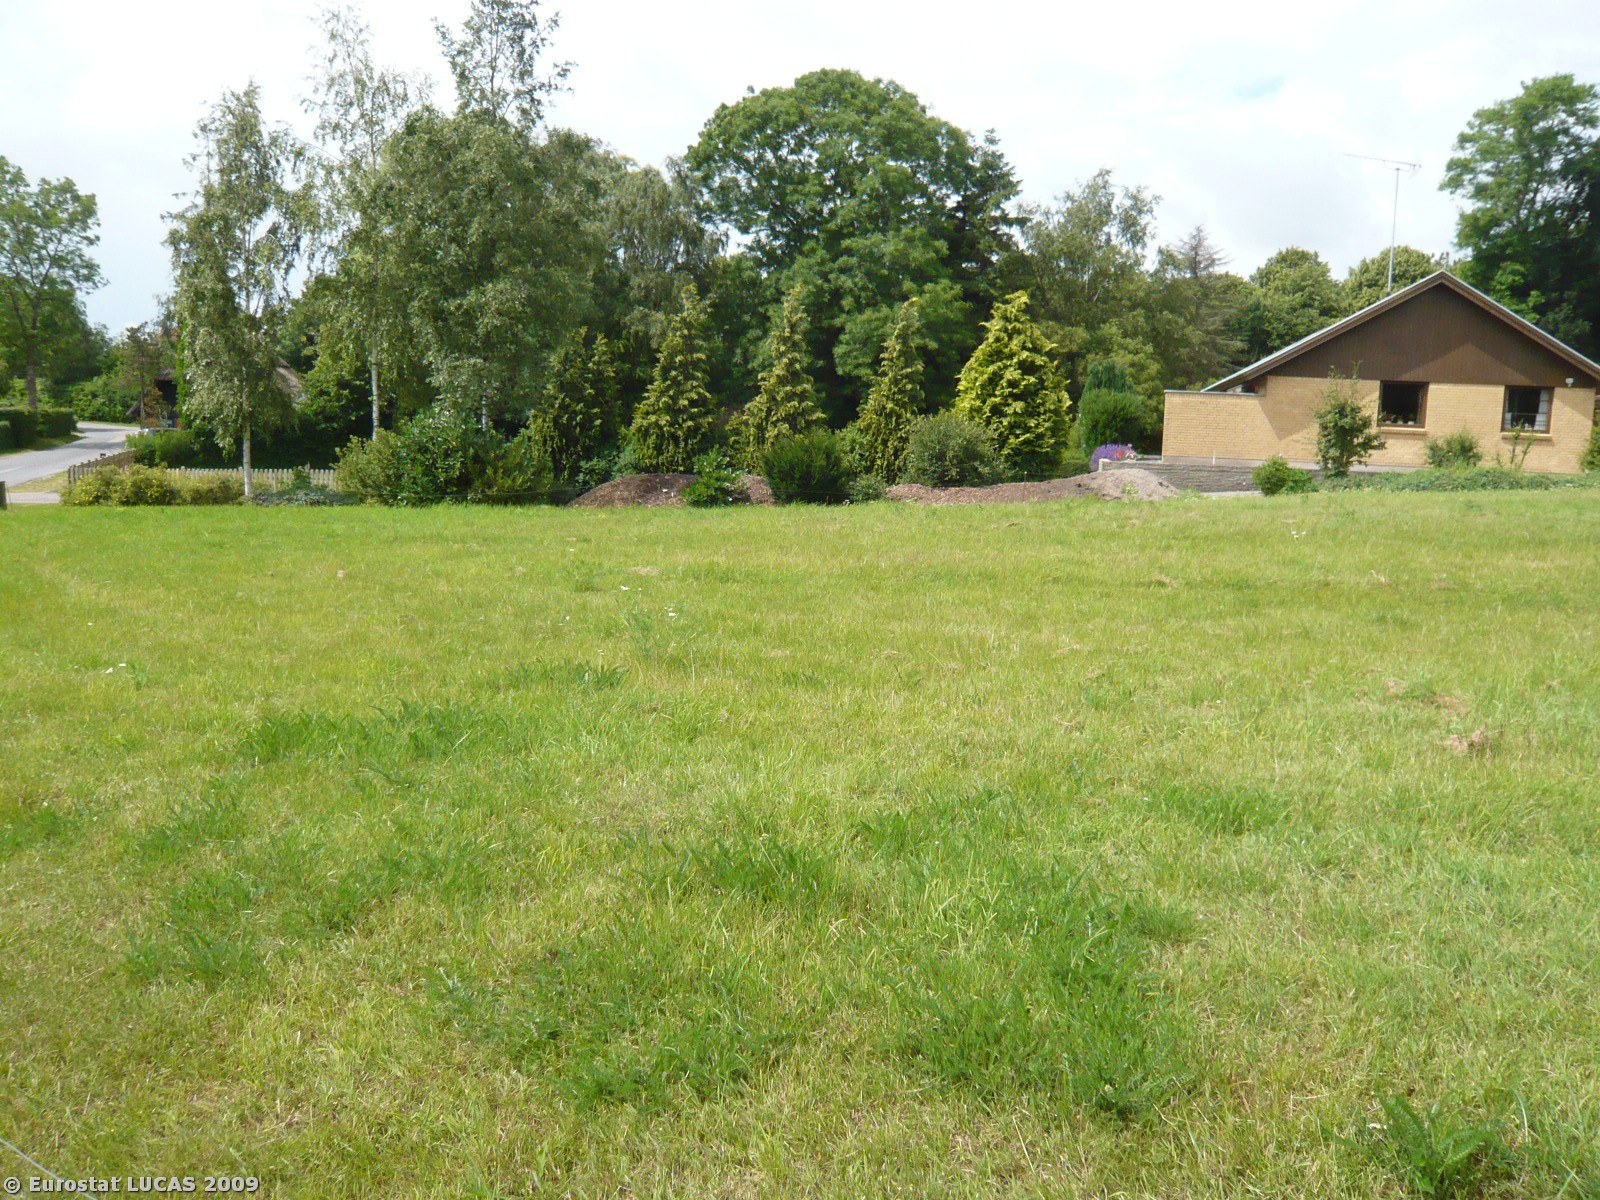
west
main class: Grassland
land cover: Grassland without tree/shrub cover
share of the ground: > 75 %
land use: Agriculture (excluding fallow land and kitchen gardens)
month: July
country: DK
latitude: 55.3538
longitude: 11.3395
